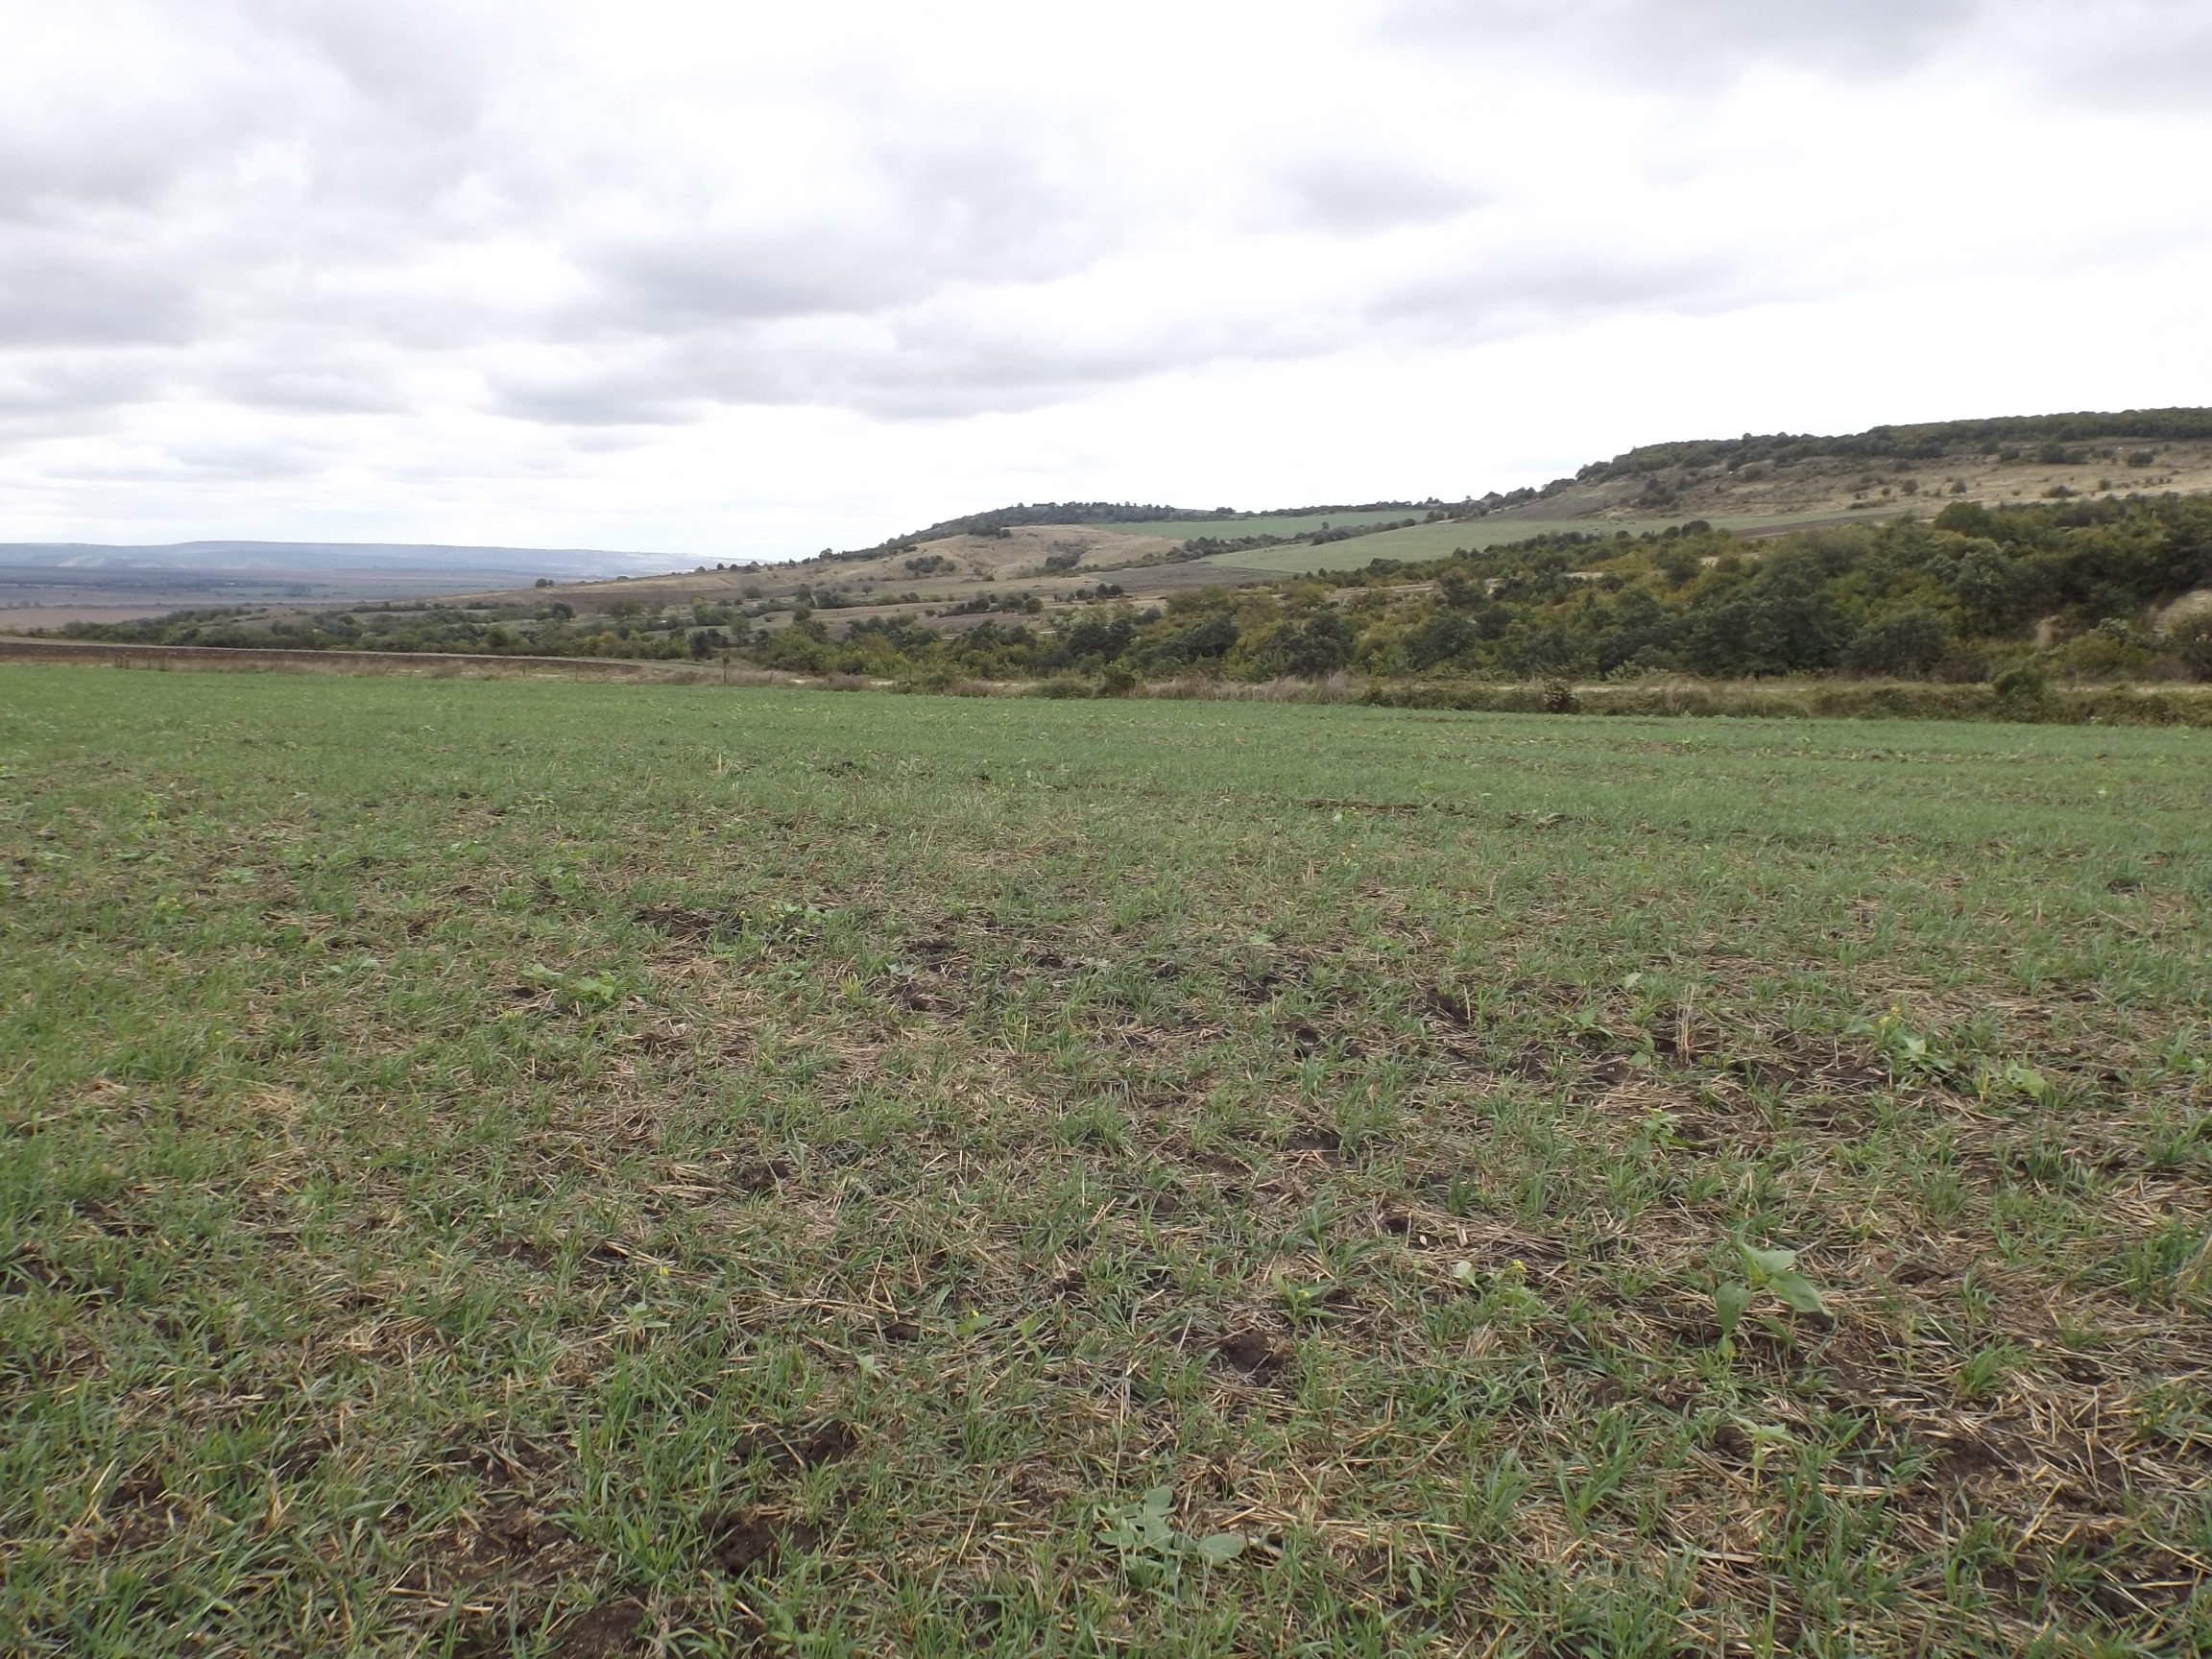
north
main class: Cropland
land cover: Common wheat
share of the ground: < 10 %
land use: Agriculture (excluding fallow land and kitchen gardens)
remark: Harvested field
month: September
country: BG
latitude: 43.0957
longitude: 27.4600
